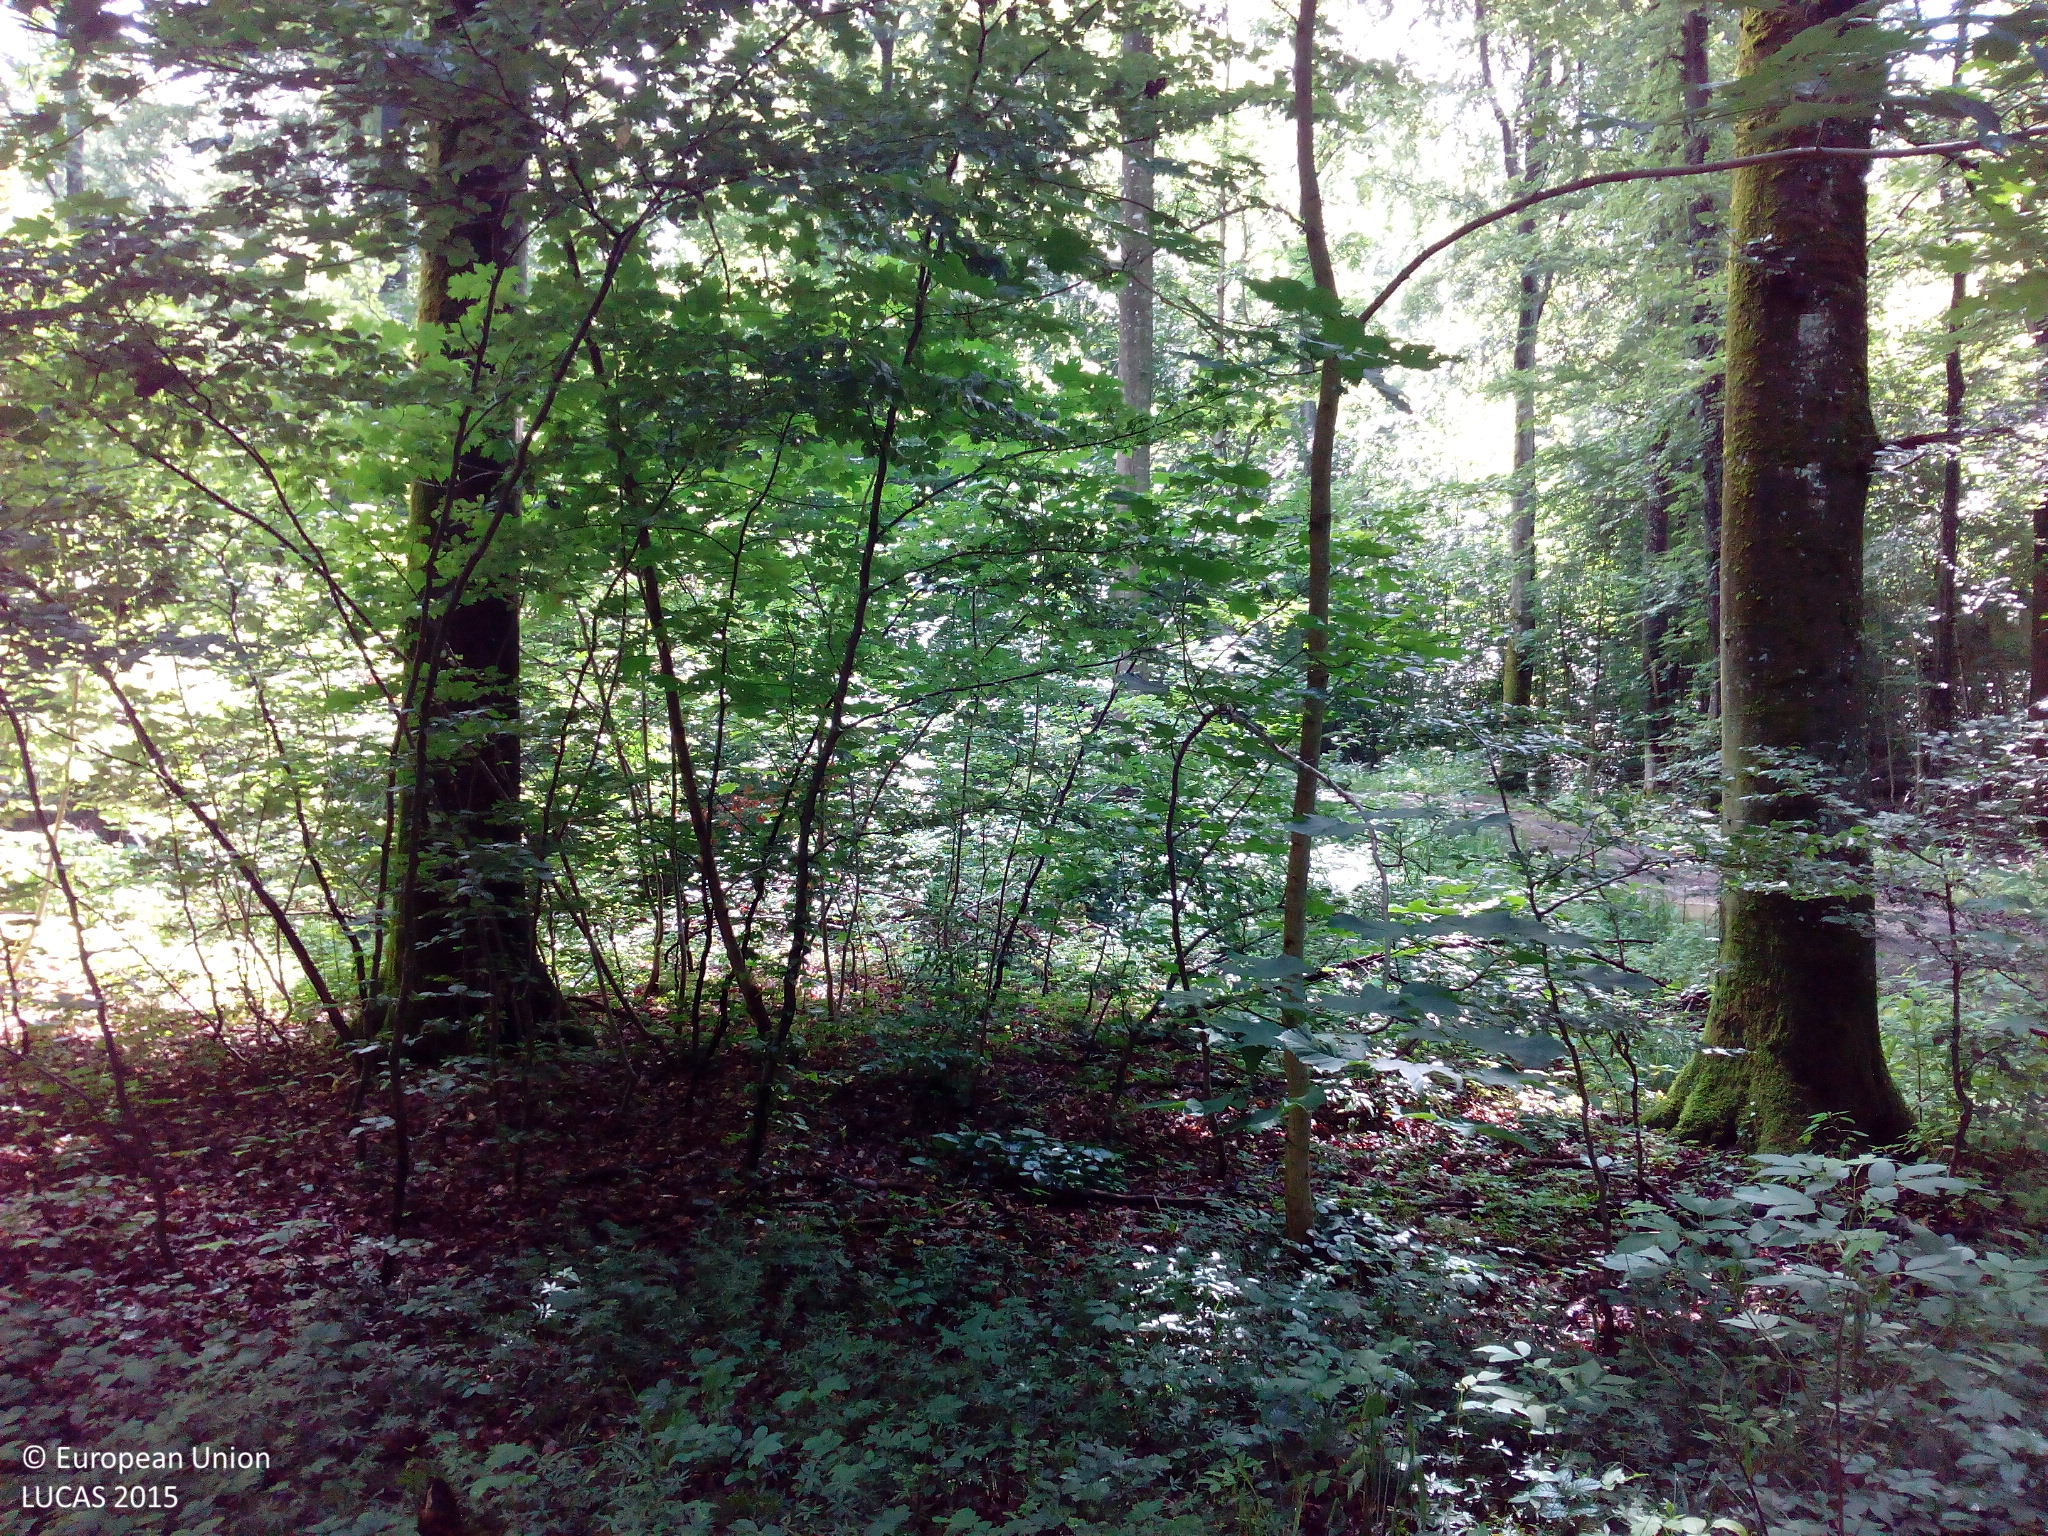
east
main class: Woodland
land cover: Broadleaved woodland
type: mesophytic deciduous forest
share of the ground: > 75 %
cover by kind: broadleaved forest trees 90 %, shrubs 5 %, herbaceous plants 5 %
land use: Forestry
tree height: > 5 m
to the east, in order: Broadleaved woodland; Tracks; Broadleaved woodland; Tracks; Broadleaved woodland
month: June
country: DE
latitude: 48.5459
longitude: 9.4178
